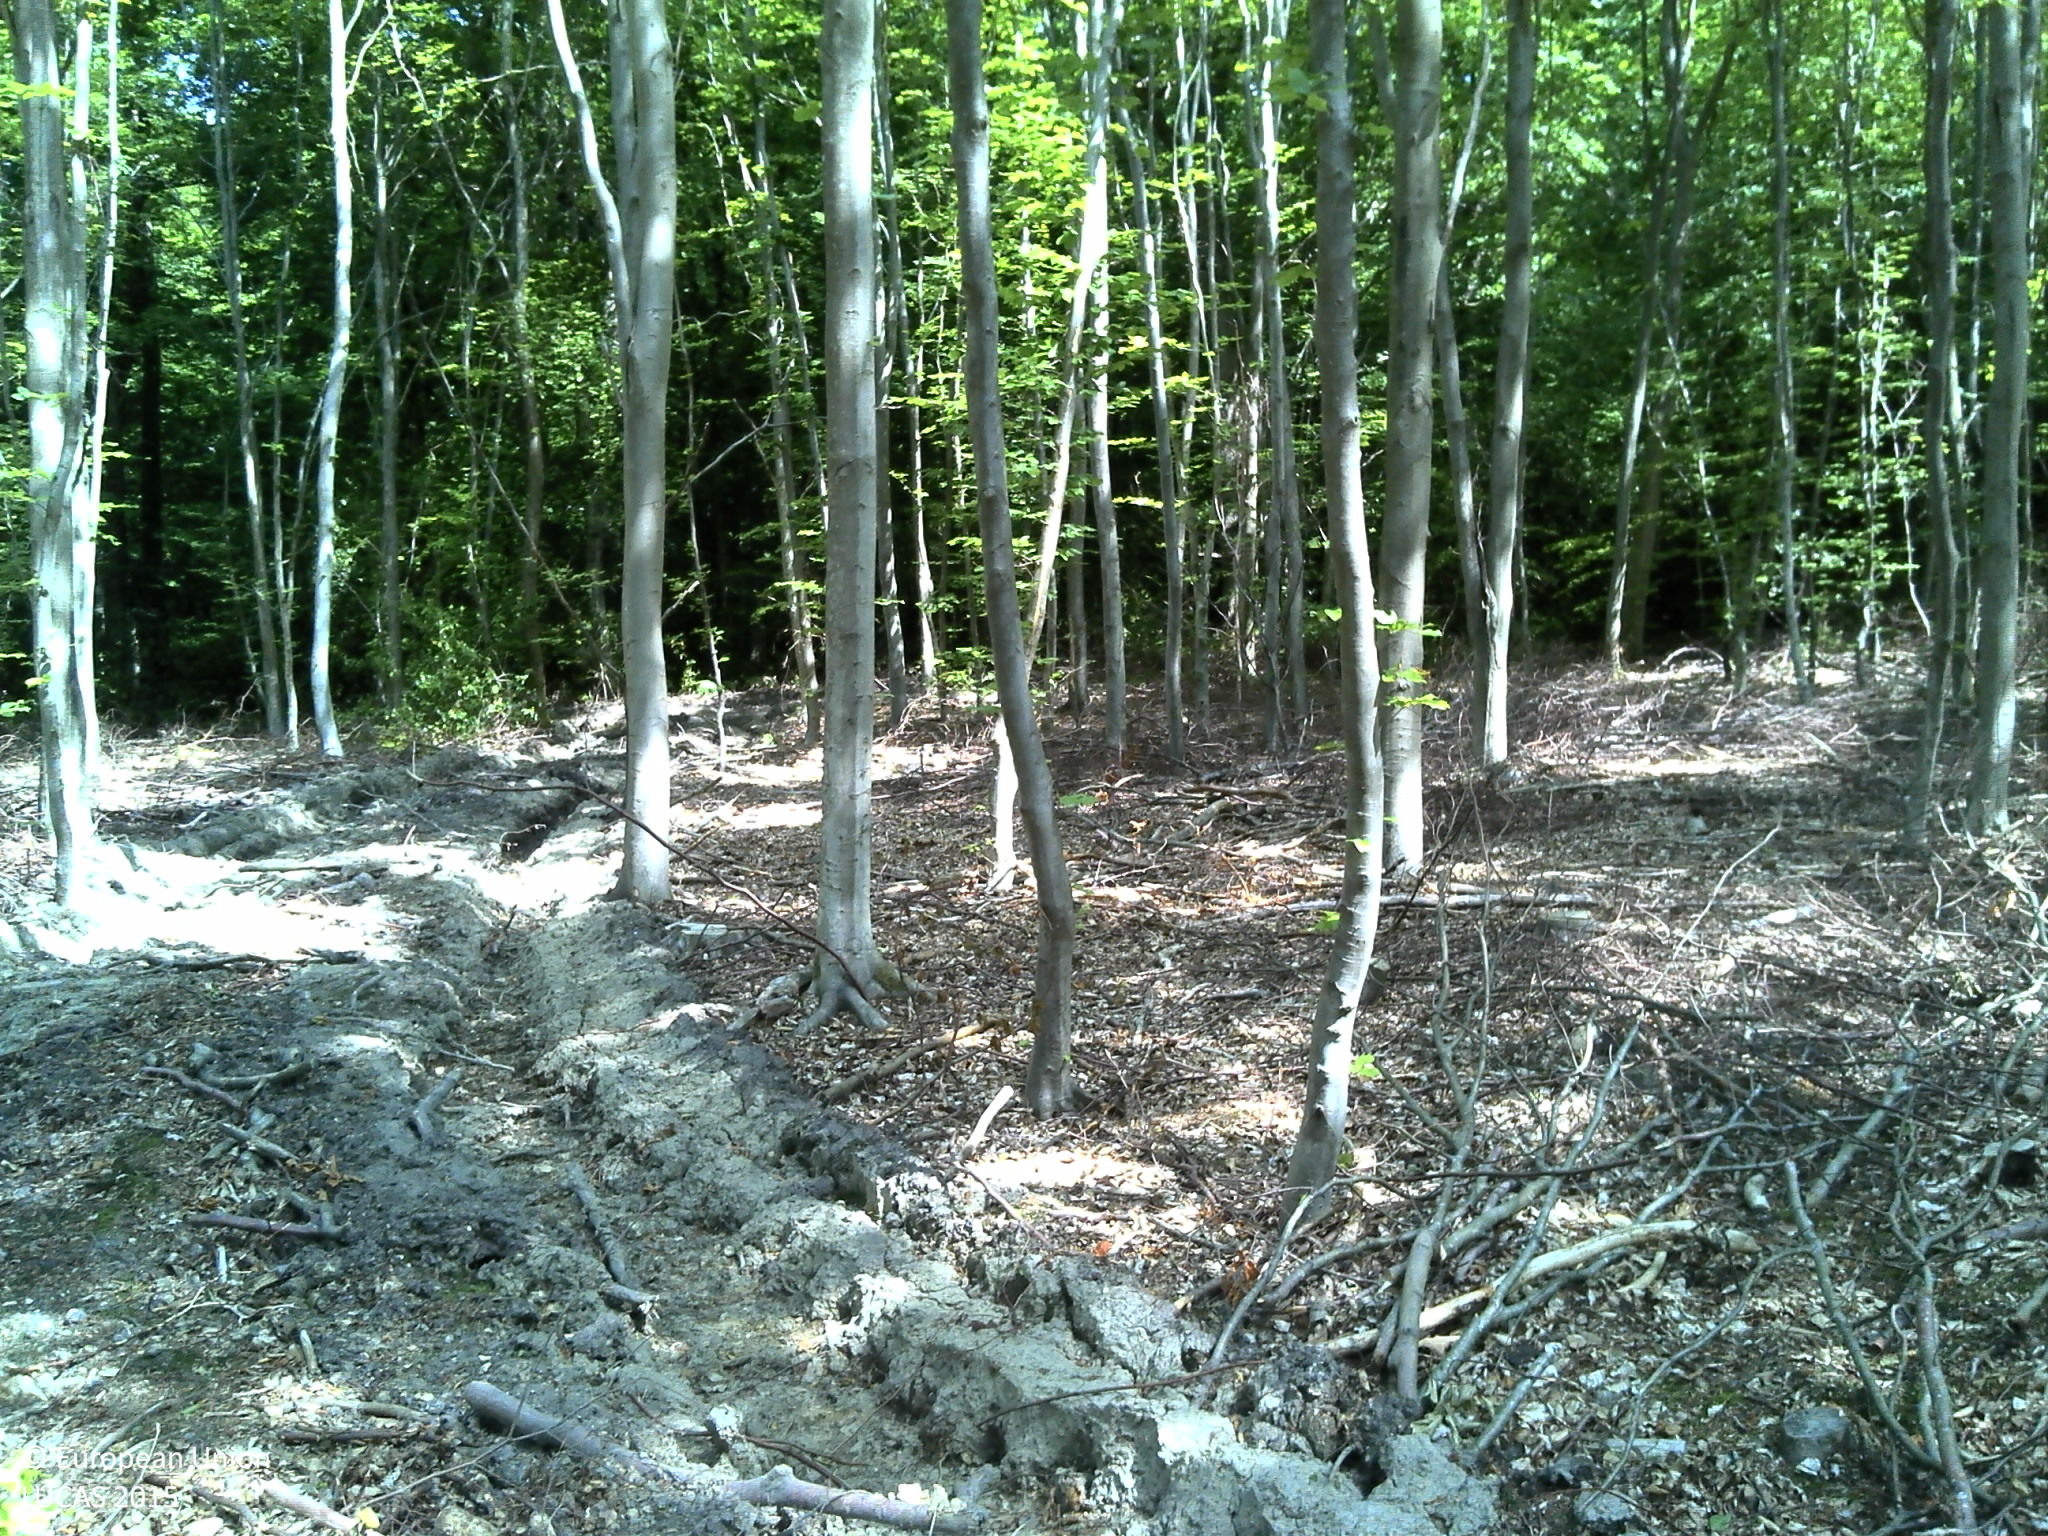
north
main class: Woodland
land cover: Broadleaved woodland
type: beech forest
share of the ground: > 75 %
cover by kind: broadleaved forest trees 90 %, consolidated bare surface 10 %
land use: Forestry
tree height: > 5 m
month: June
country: FR
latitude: 49.5098
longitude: 1.0982
